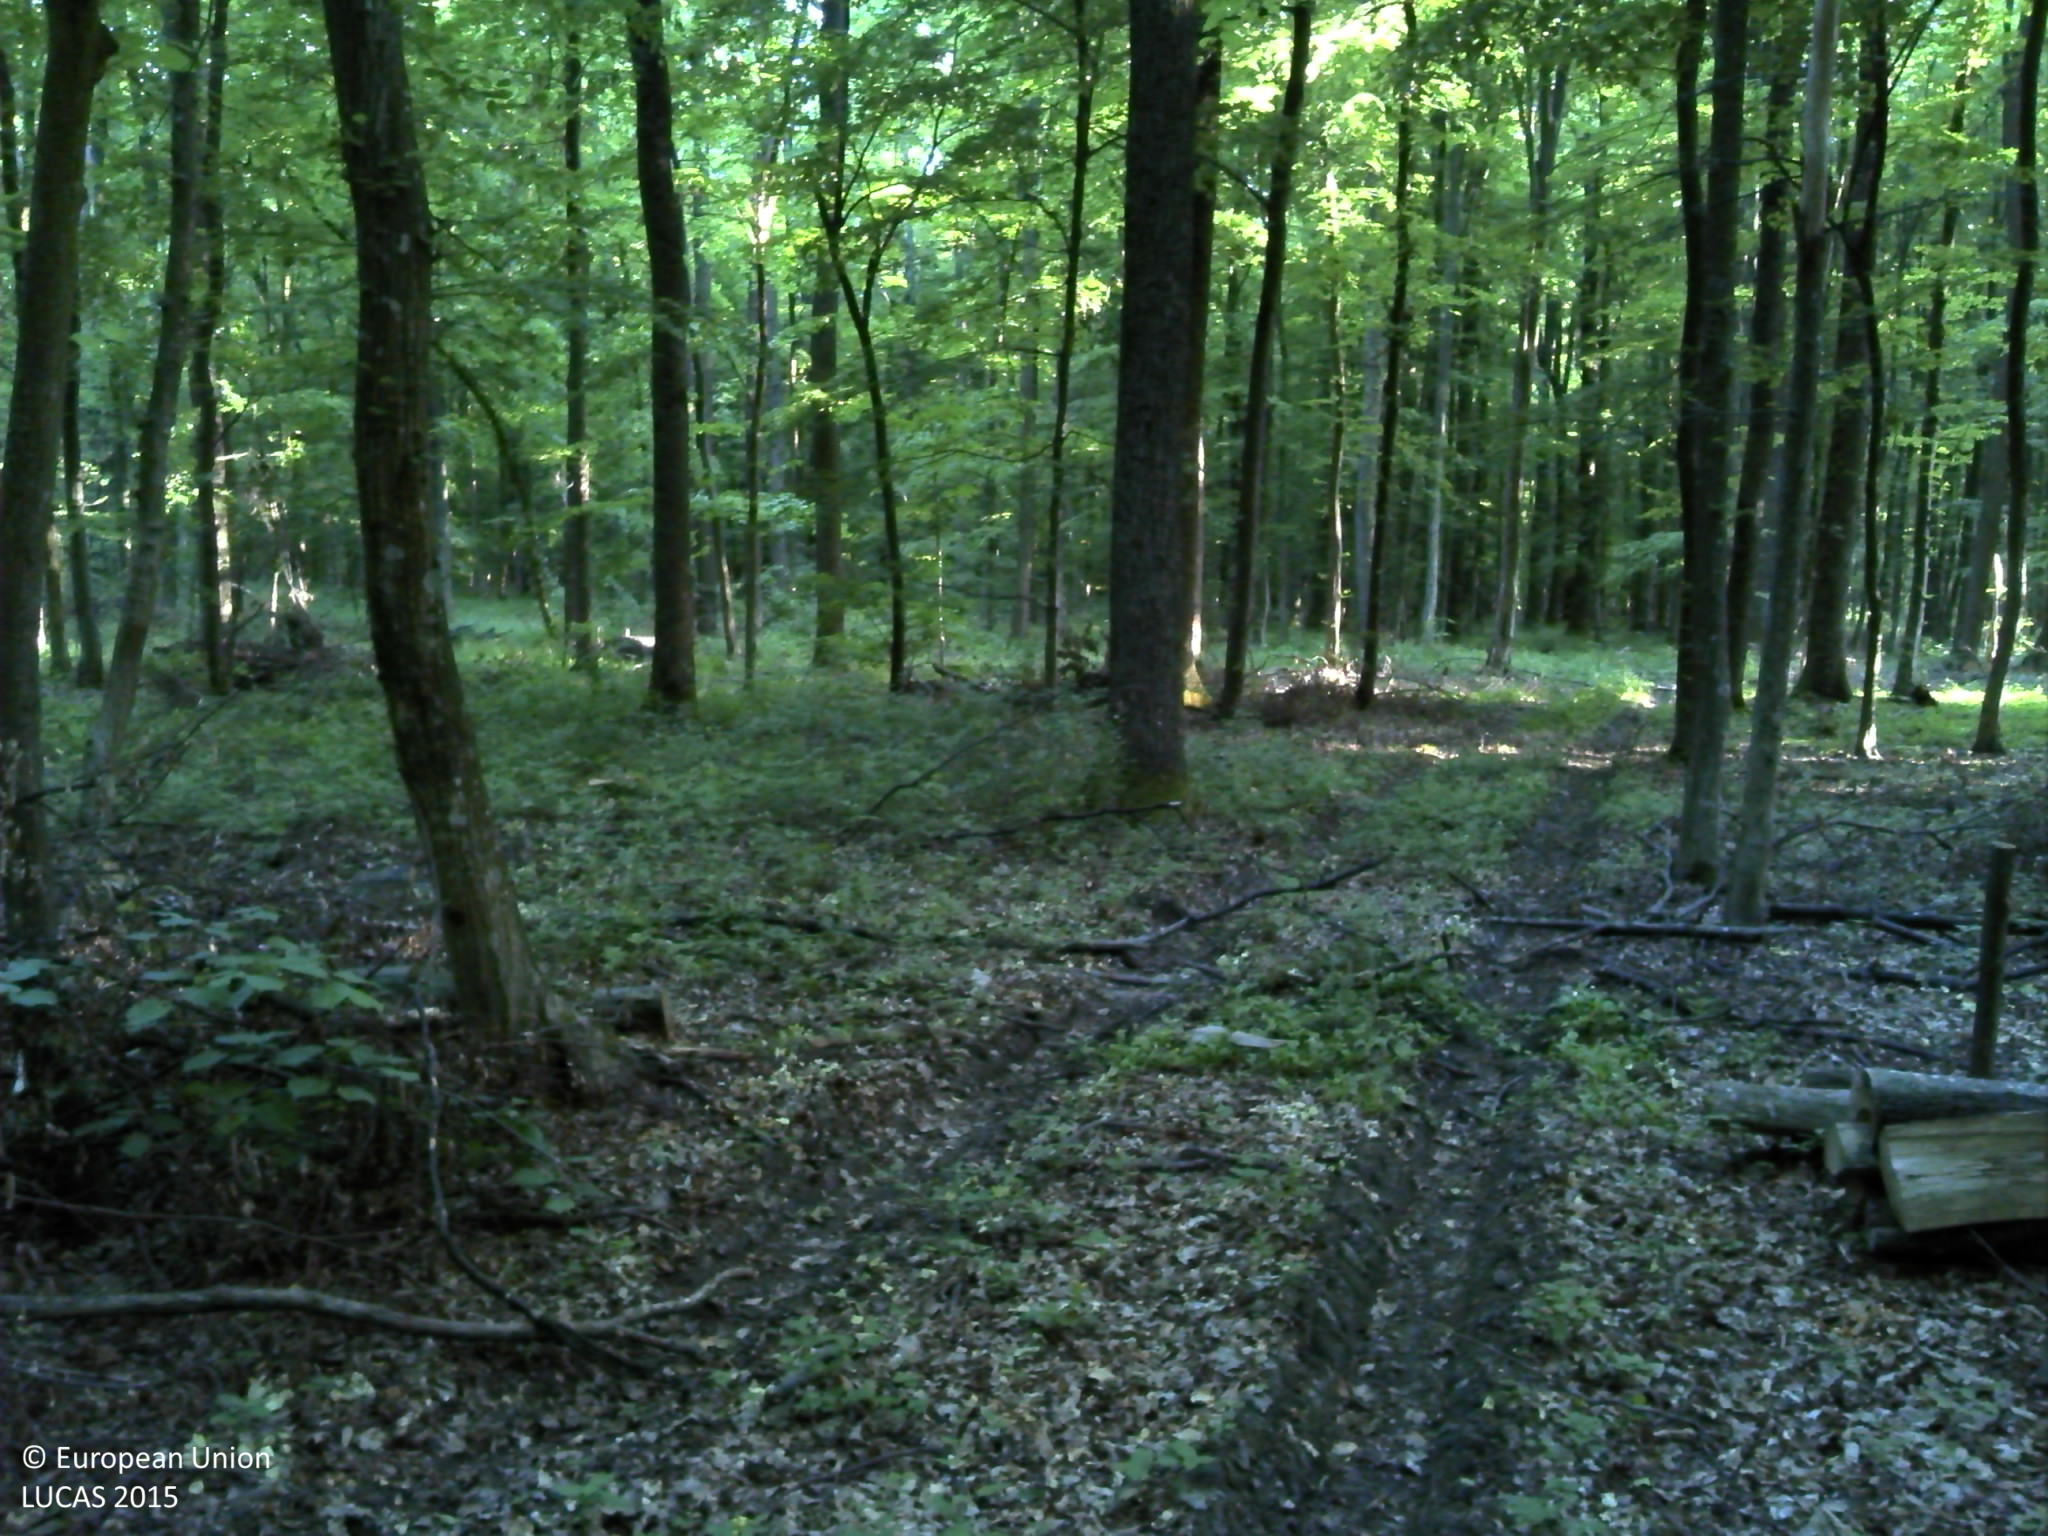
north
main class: Woodland
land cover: Broadleaved woodland
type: acidophilous oak and oak-birch forest
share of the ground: > 75 %
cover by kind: broadleaved forest trees 100 %
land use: Forestry
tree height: > 5 m
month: May
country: HR
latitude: 45.4904
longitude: 18.2324
